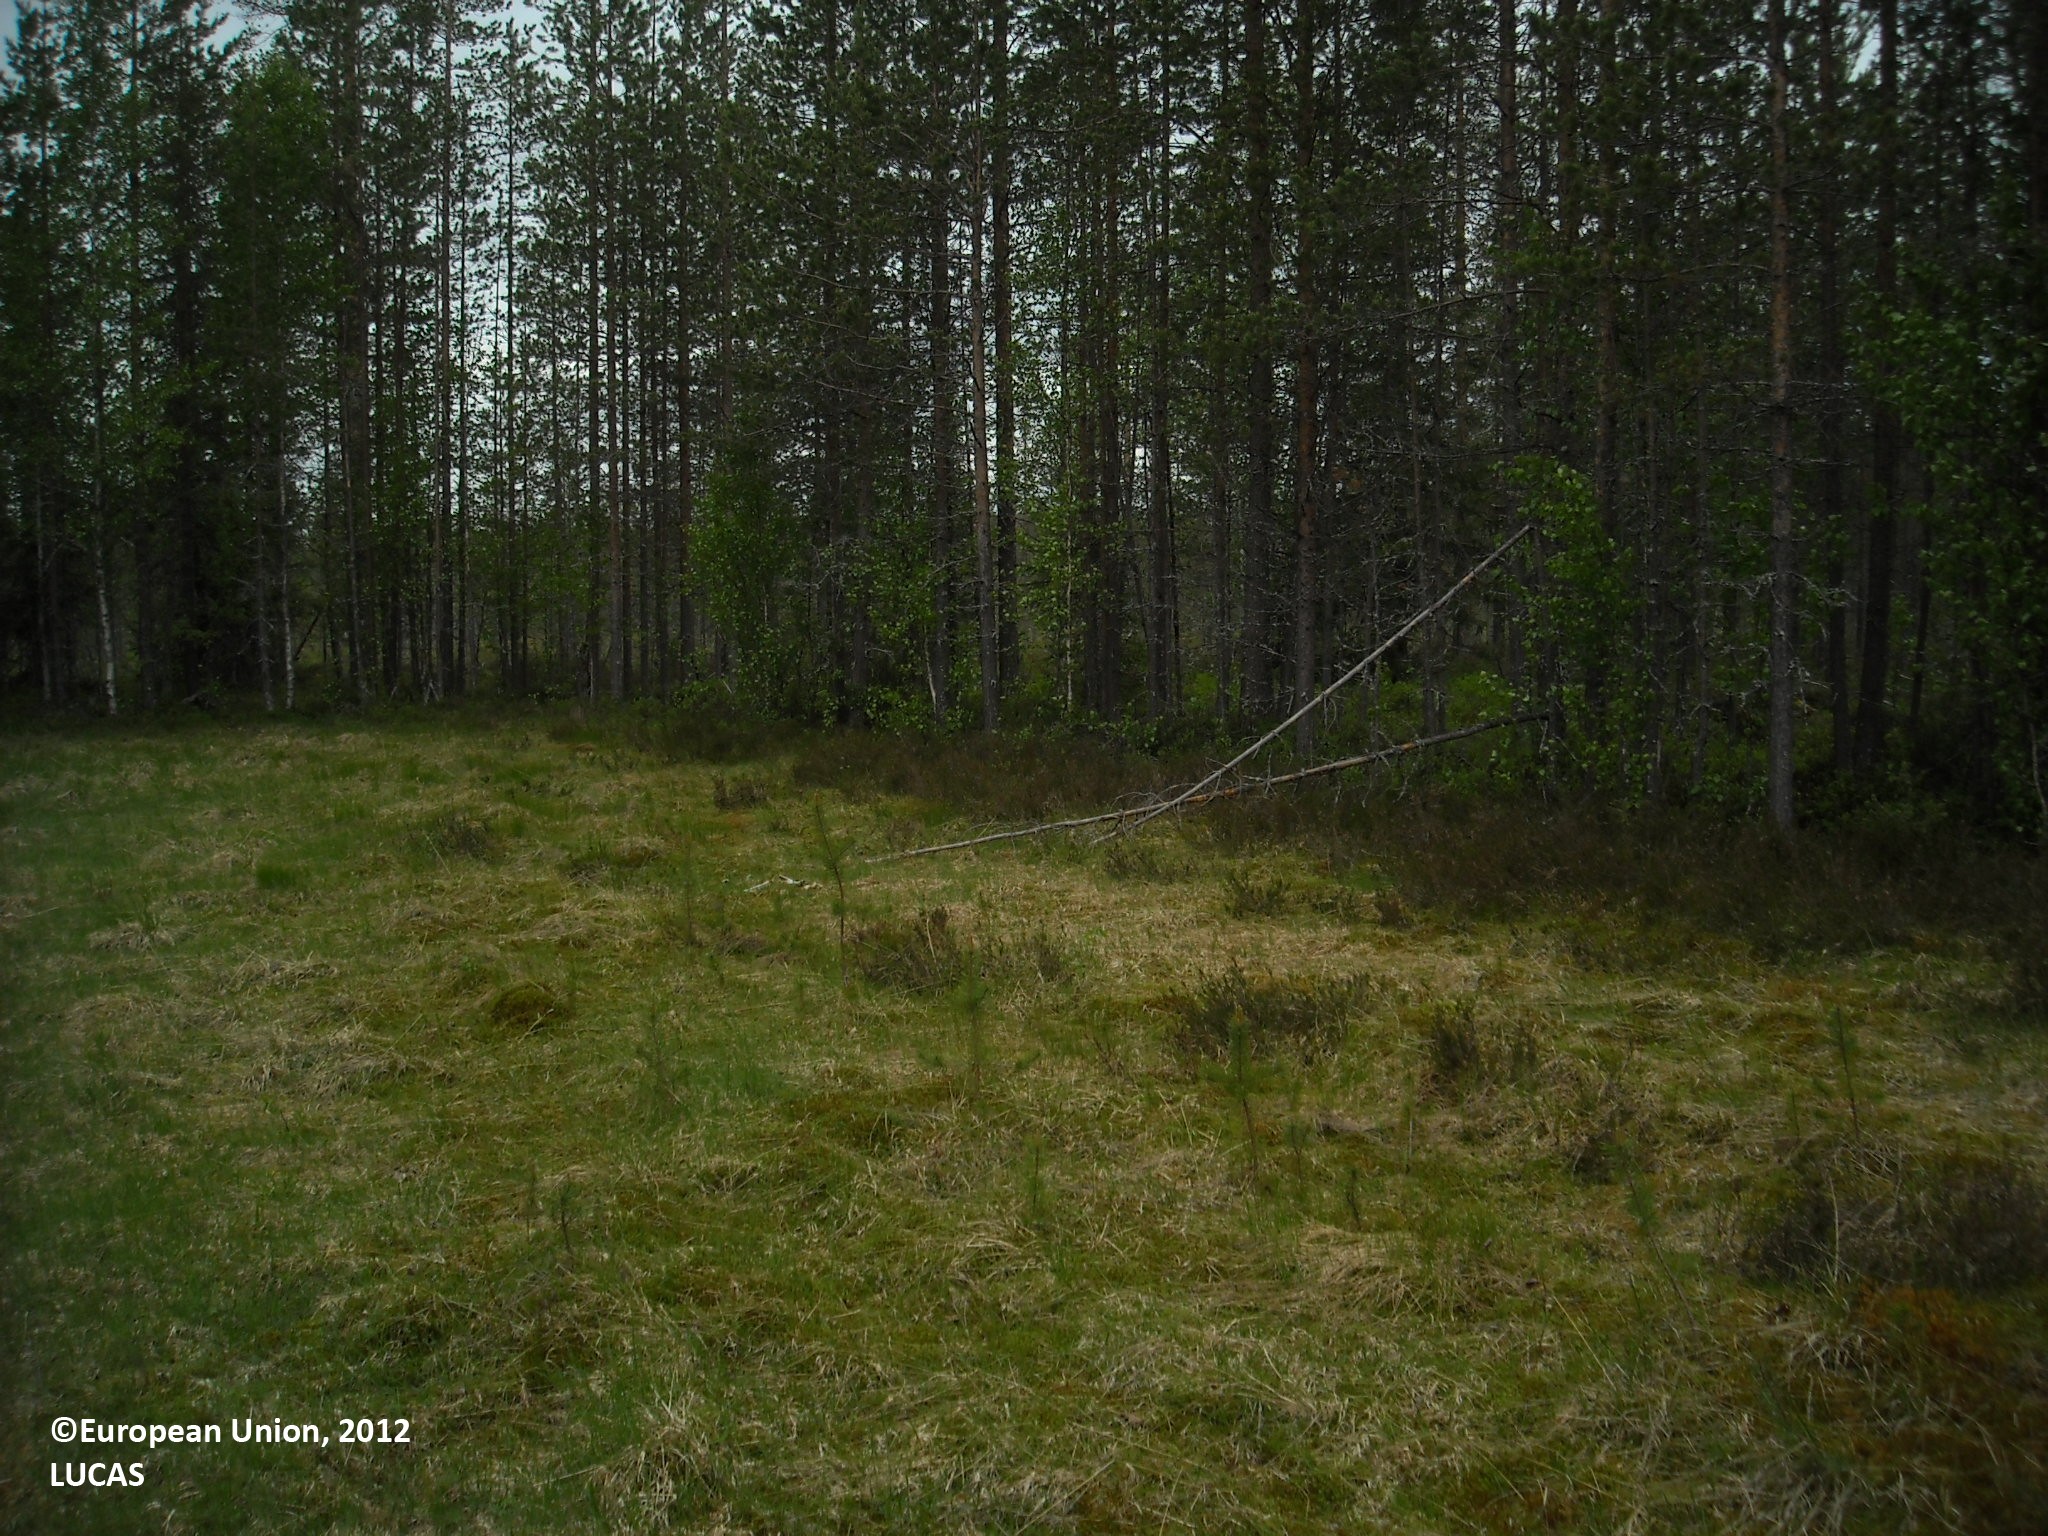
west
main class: Grassland
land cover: Grassland without tree/shrub cover
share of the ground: > 75 %
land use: Agriculture (excluding fallow land and kitchen gardens)
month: June
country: FI
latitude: 65.5596
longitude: 27.9697
